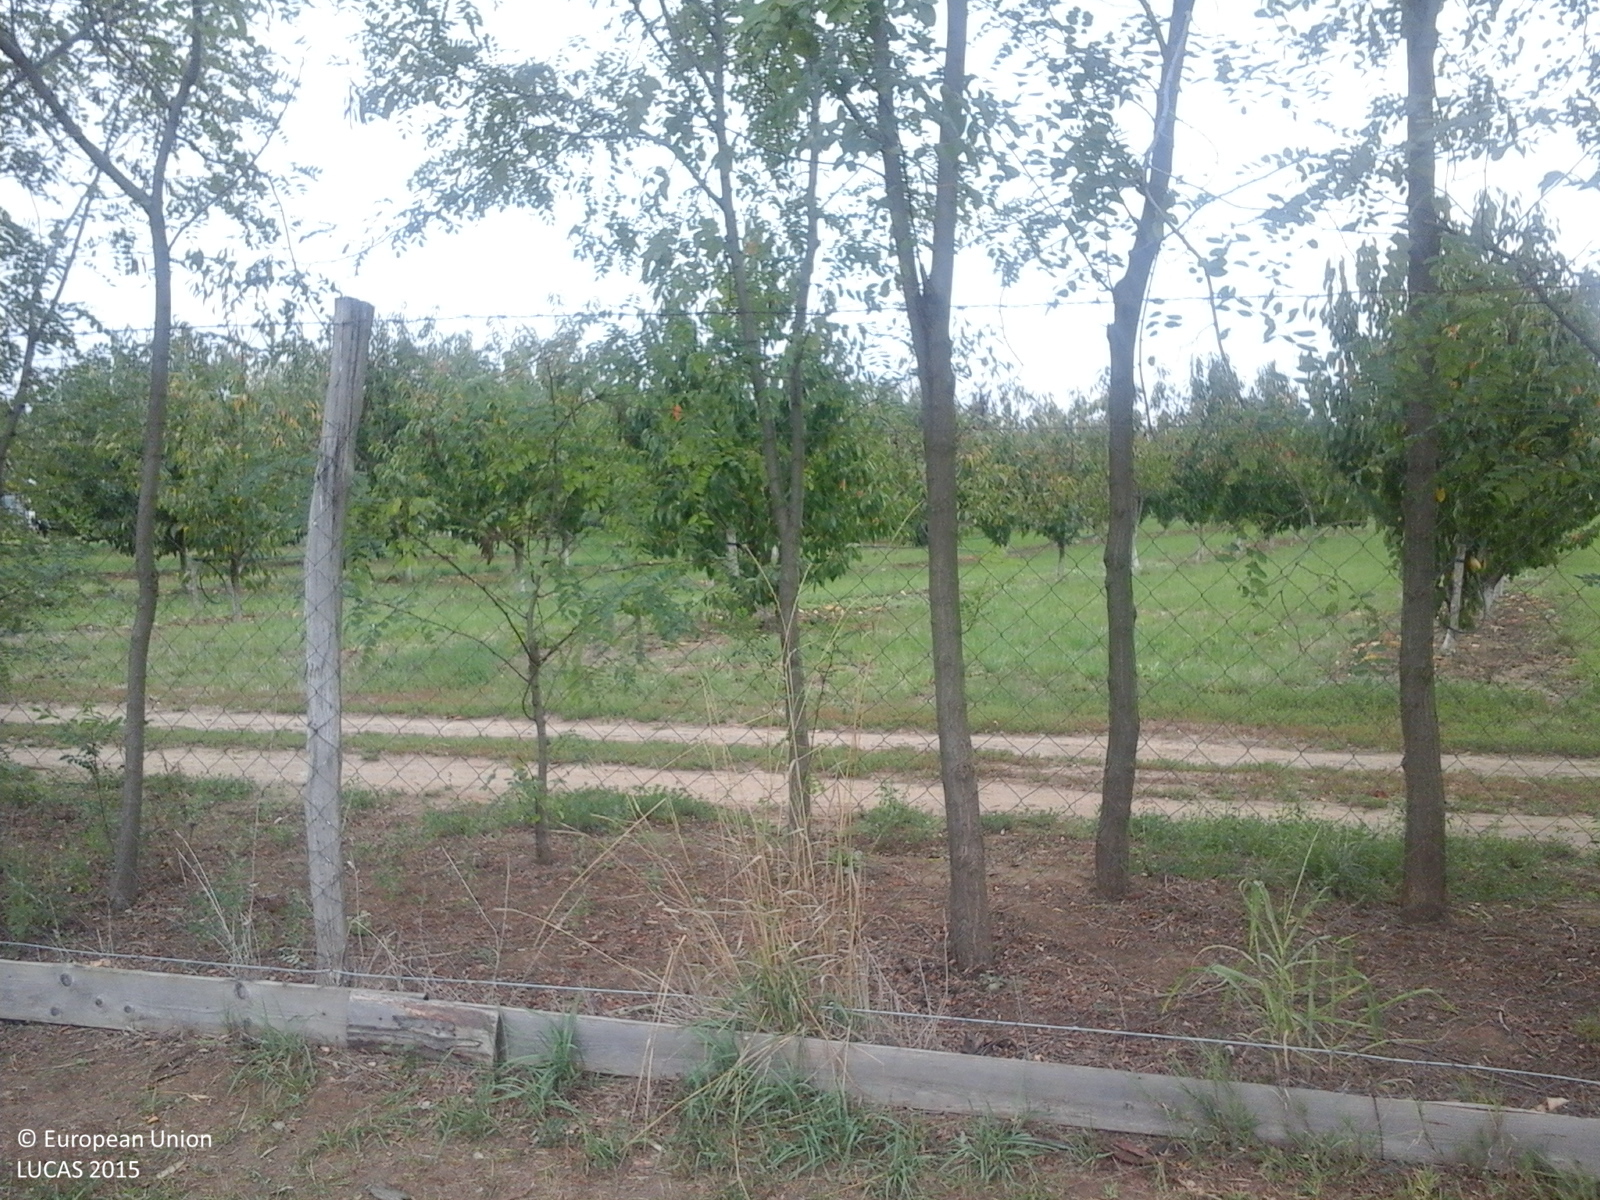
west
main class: Cropland
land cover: Cherry fruit
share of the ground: 50 - 75 %
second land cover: Grassland without tree/shrub cover
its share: > 75 %
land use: Agriculture (excluding fallow land and kitchen gardens)
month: September
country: RO
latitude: 47.3439
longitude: 22.0279
